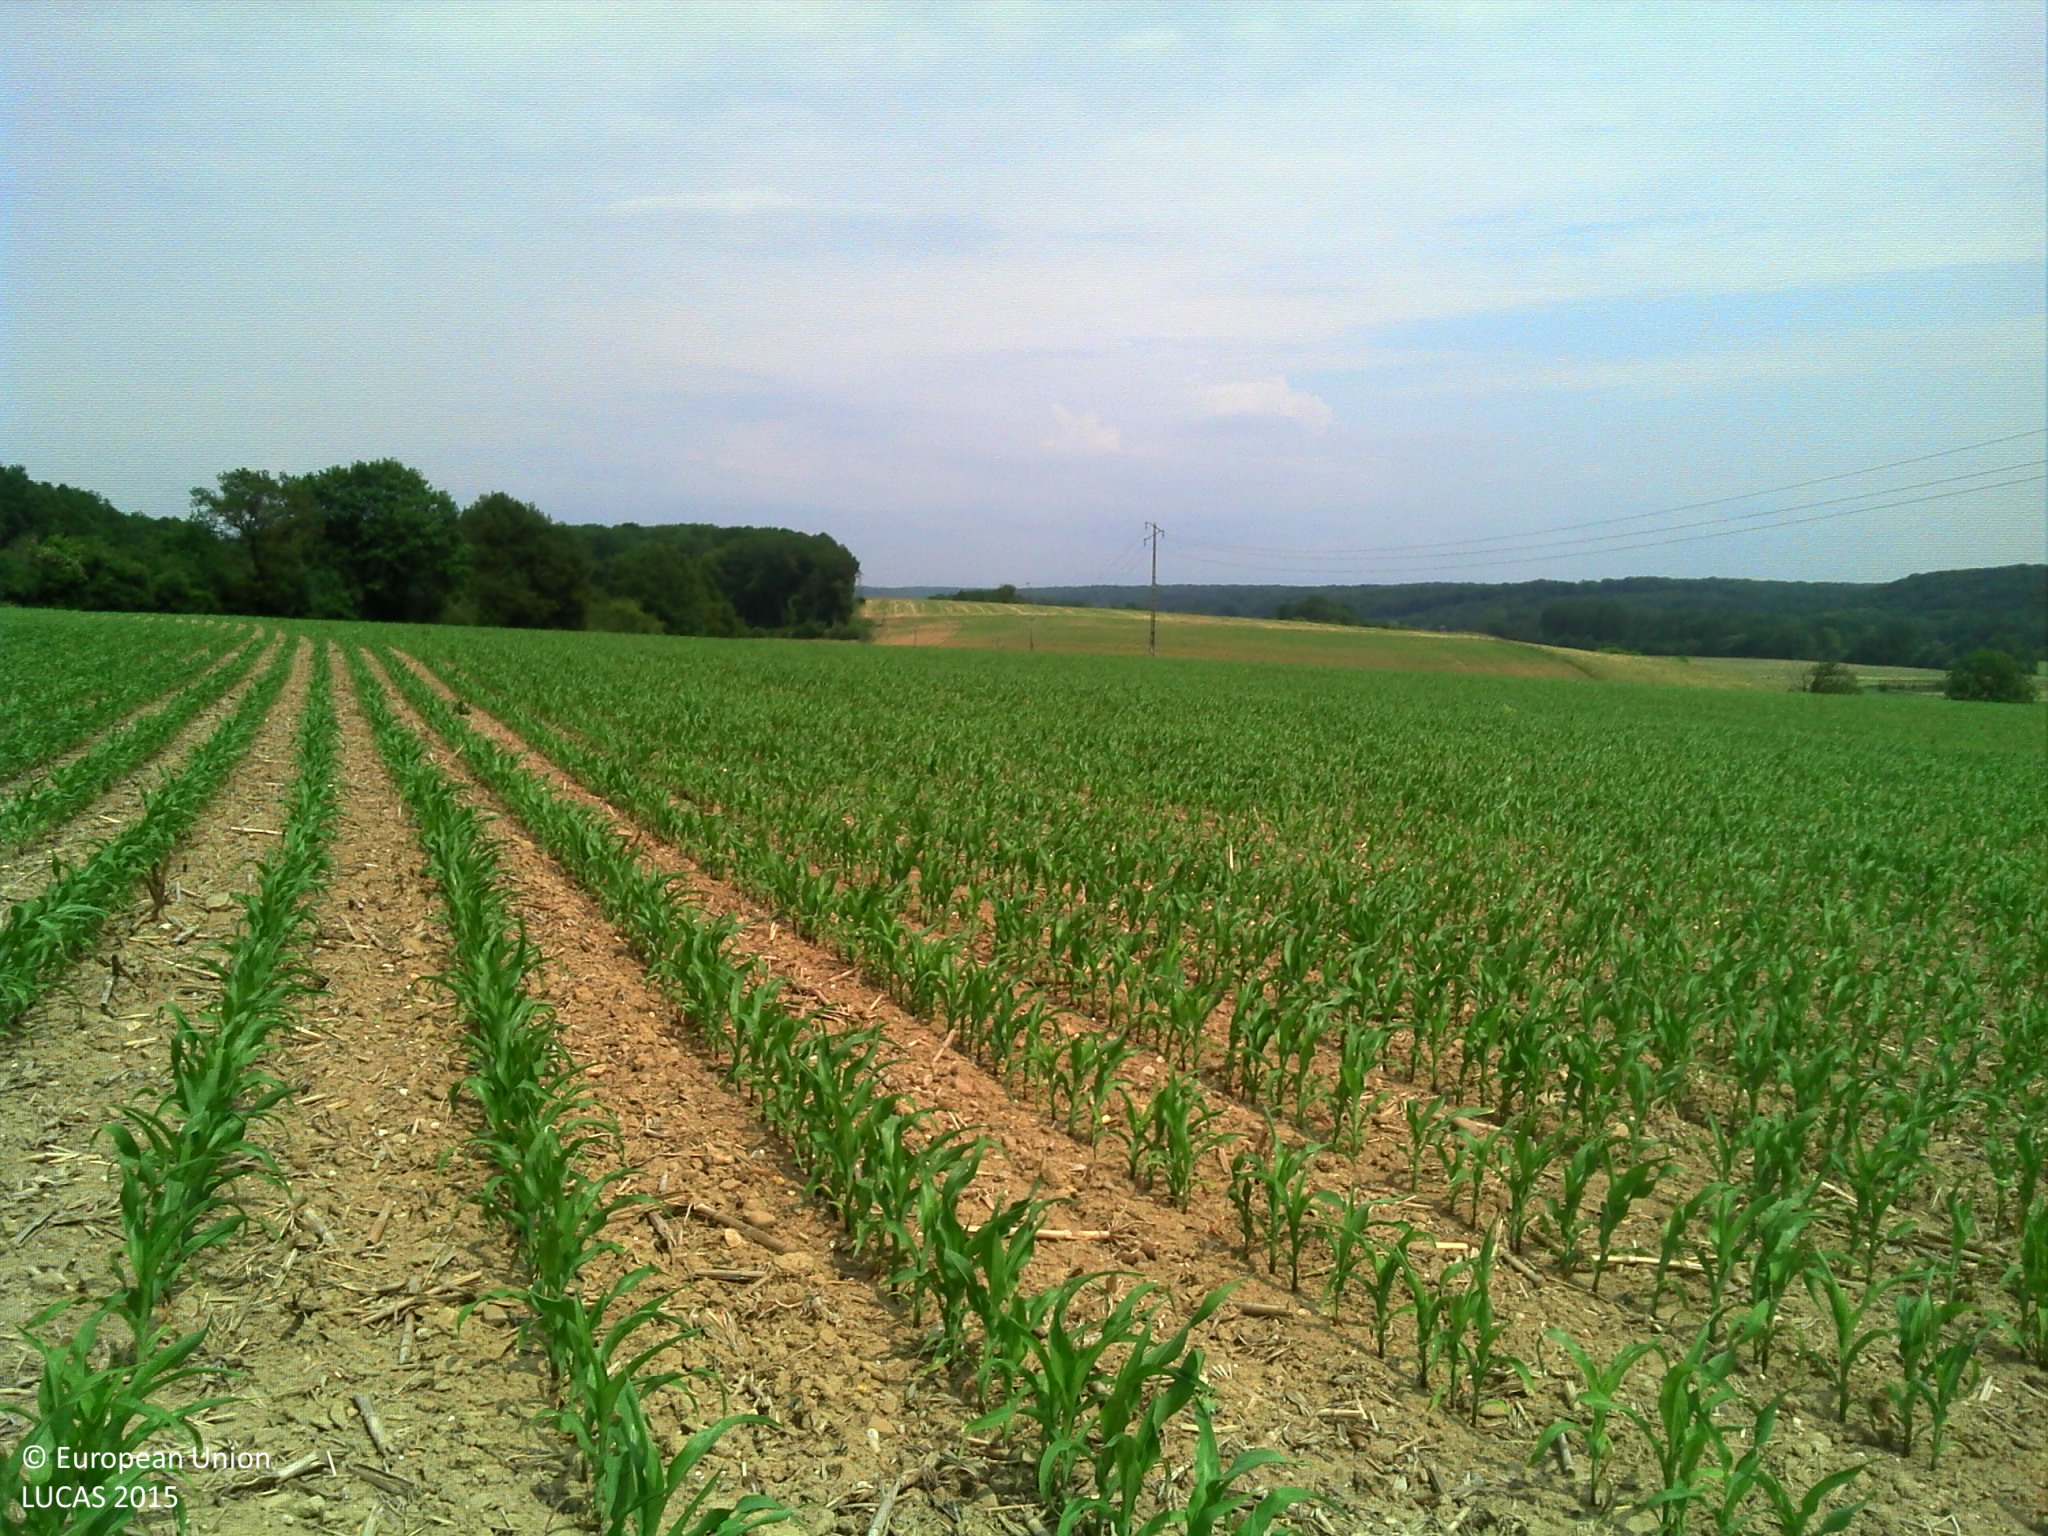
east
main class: Cropland
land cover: Maize
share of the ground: 50 - 75 %
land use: Agriculture (excluding fallow land and kitchen gardens)
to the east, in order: Maize; Electric lines; Maize
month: June
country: FR
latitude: 47.8165
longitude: 6.2214
